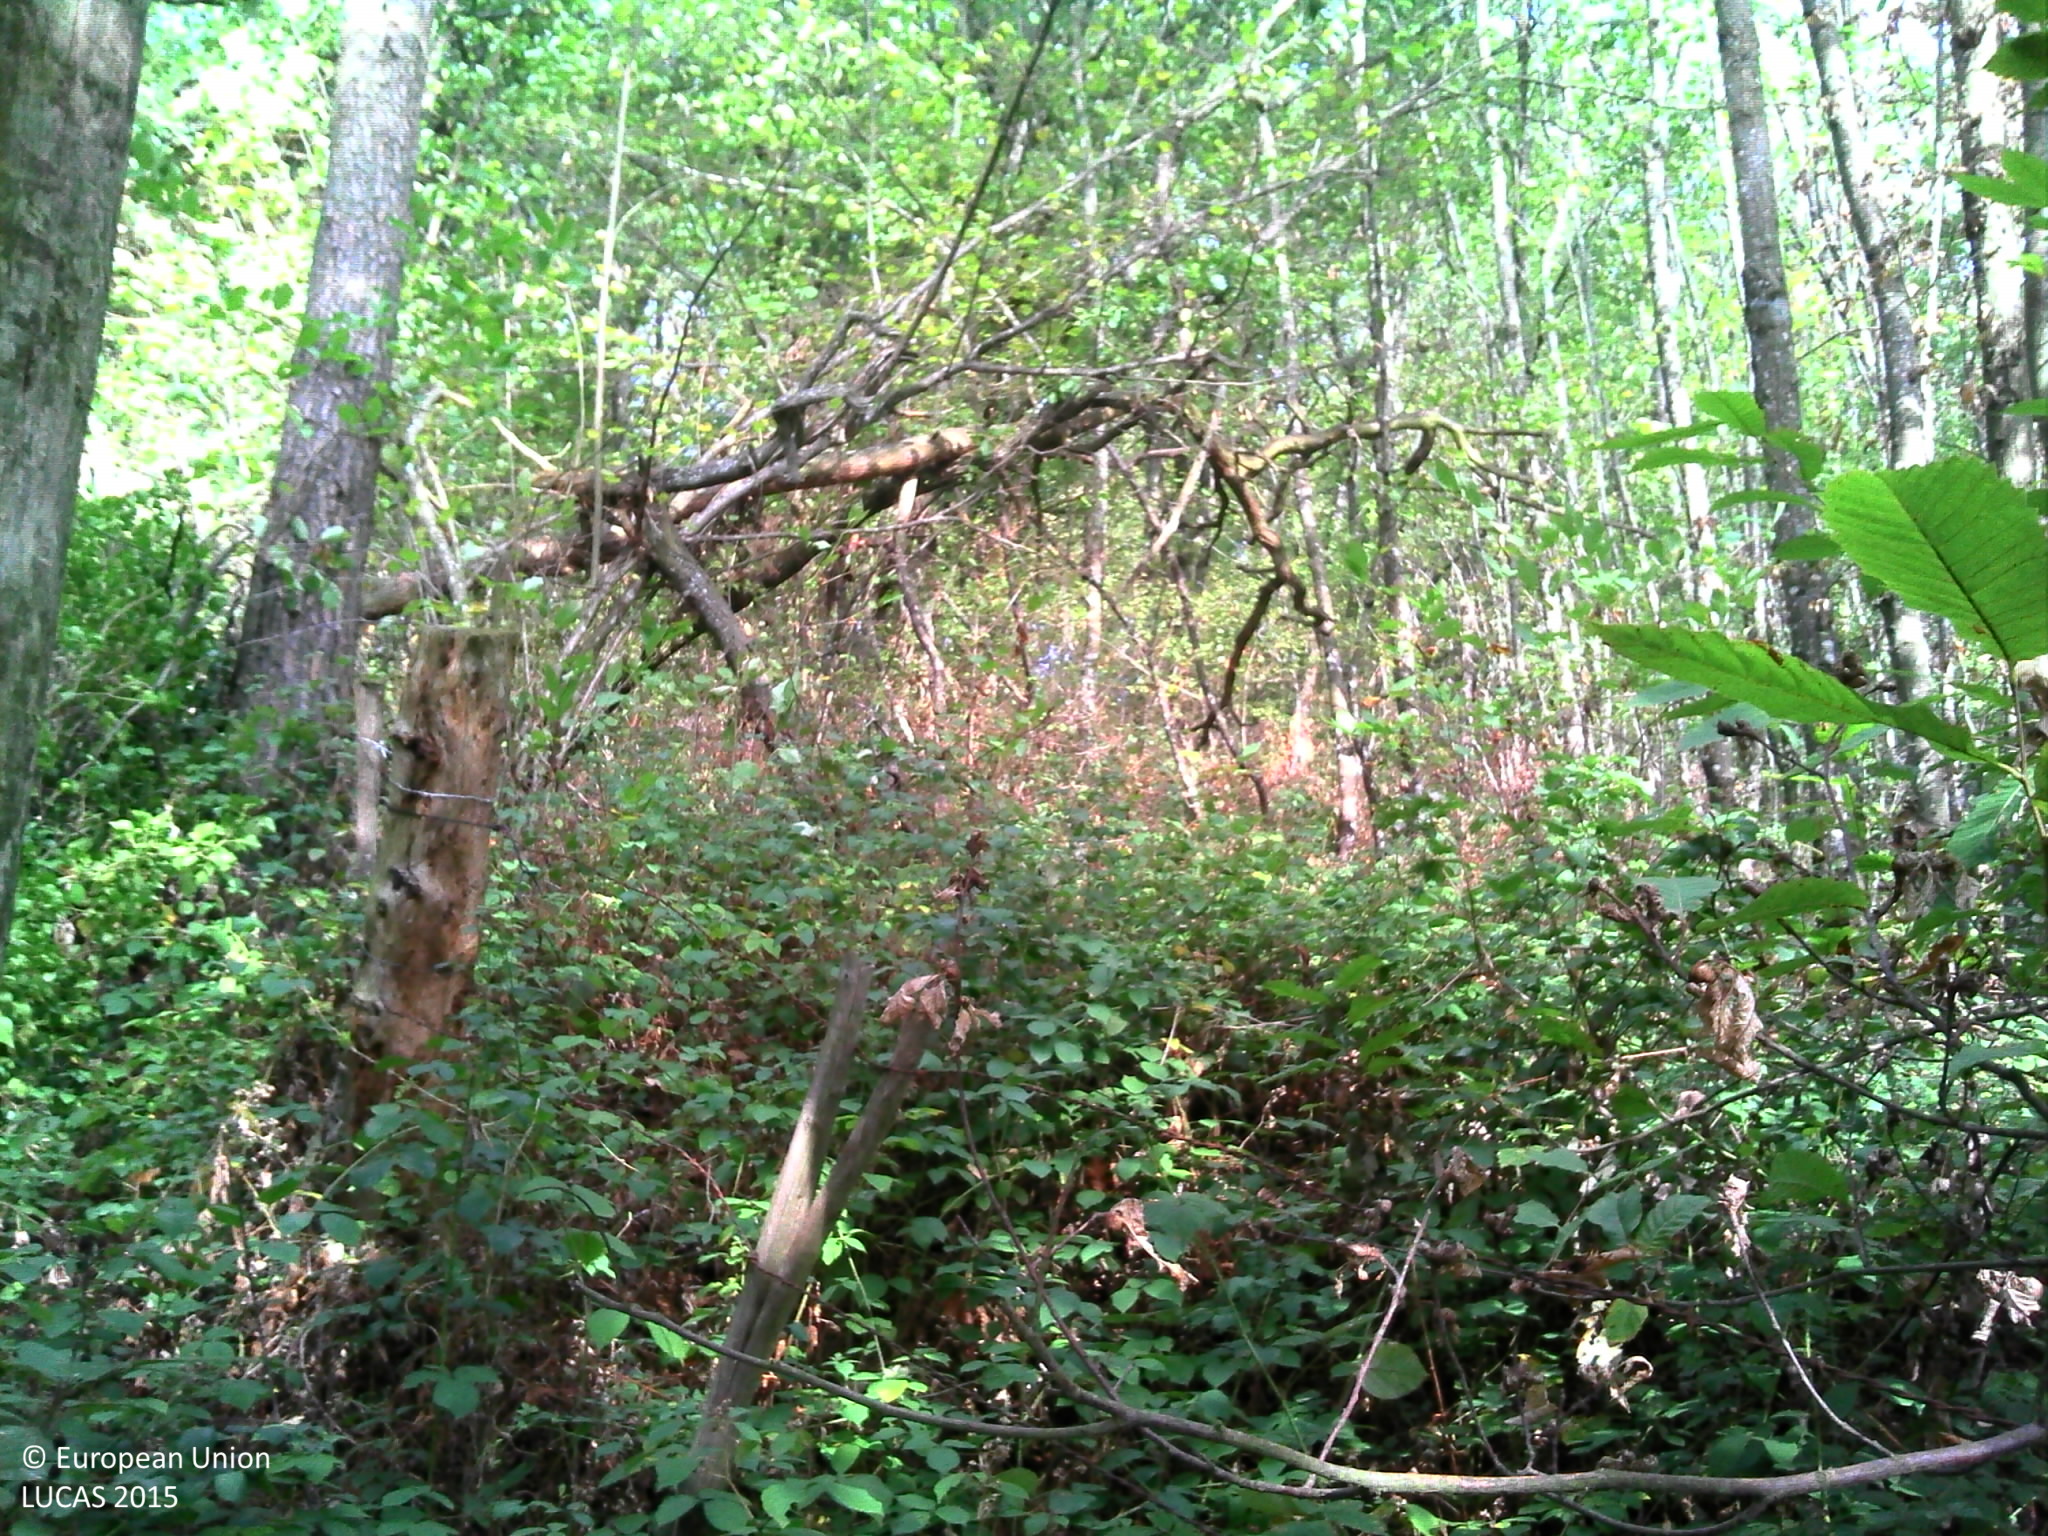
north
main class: Woodland
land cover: Broadleaved woodland
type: mesophytic deciduous forest
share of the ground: > 75 %
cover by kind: broadleaved forest trees 90 %, herbaceous plants 5 %, lichens and mosses 5 %
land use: Forestry
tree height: > 5 m
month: October
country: FR
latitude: 45.6385
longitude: 4.6282
